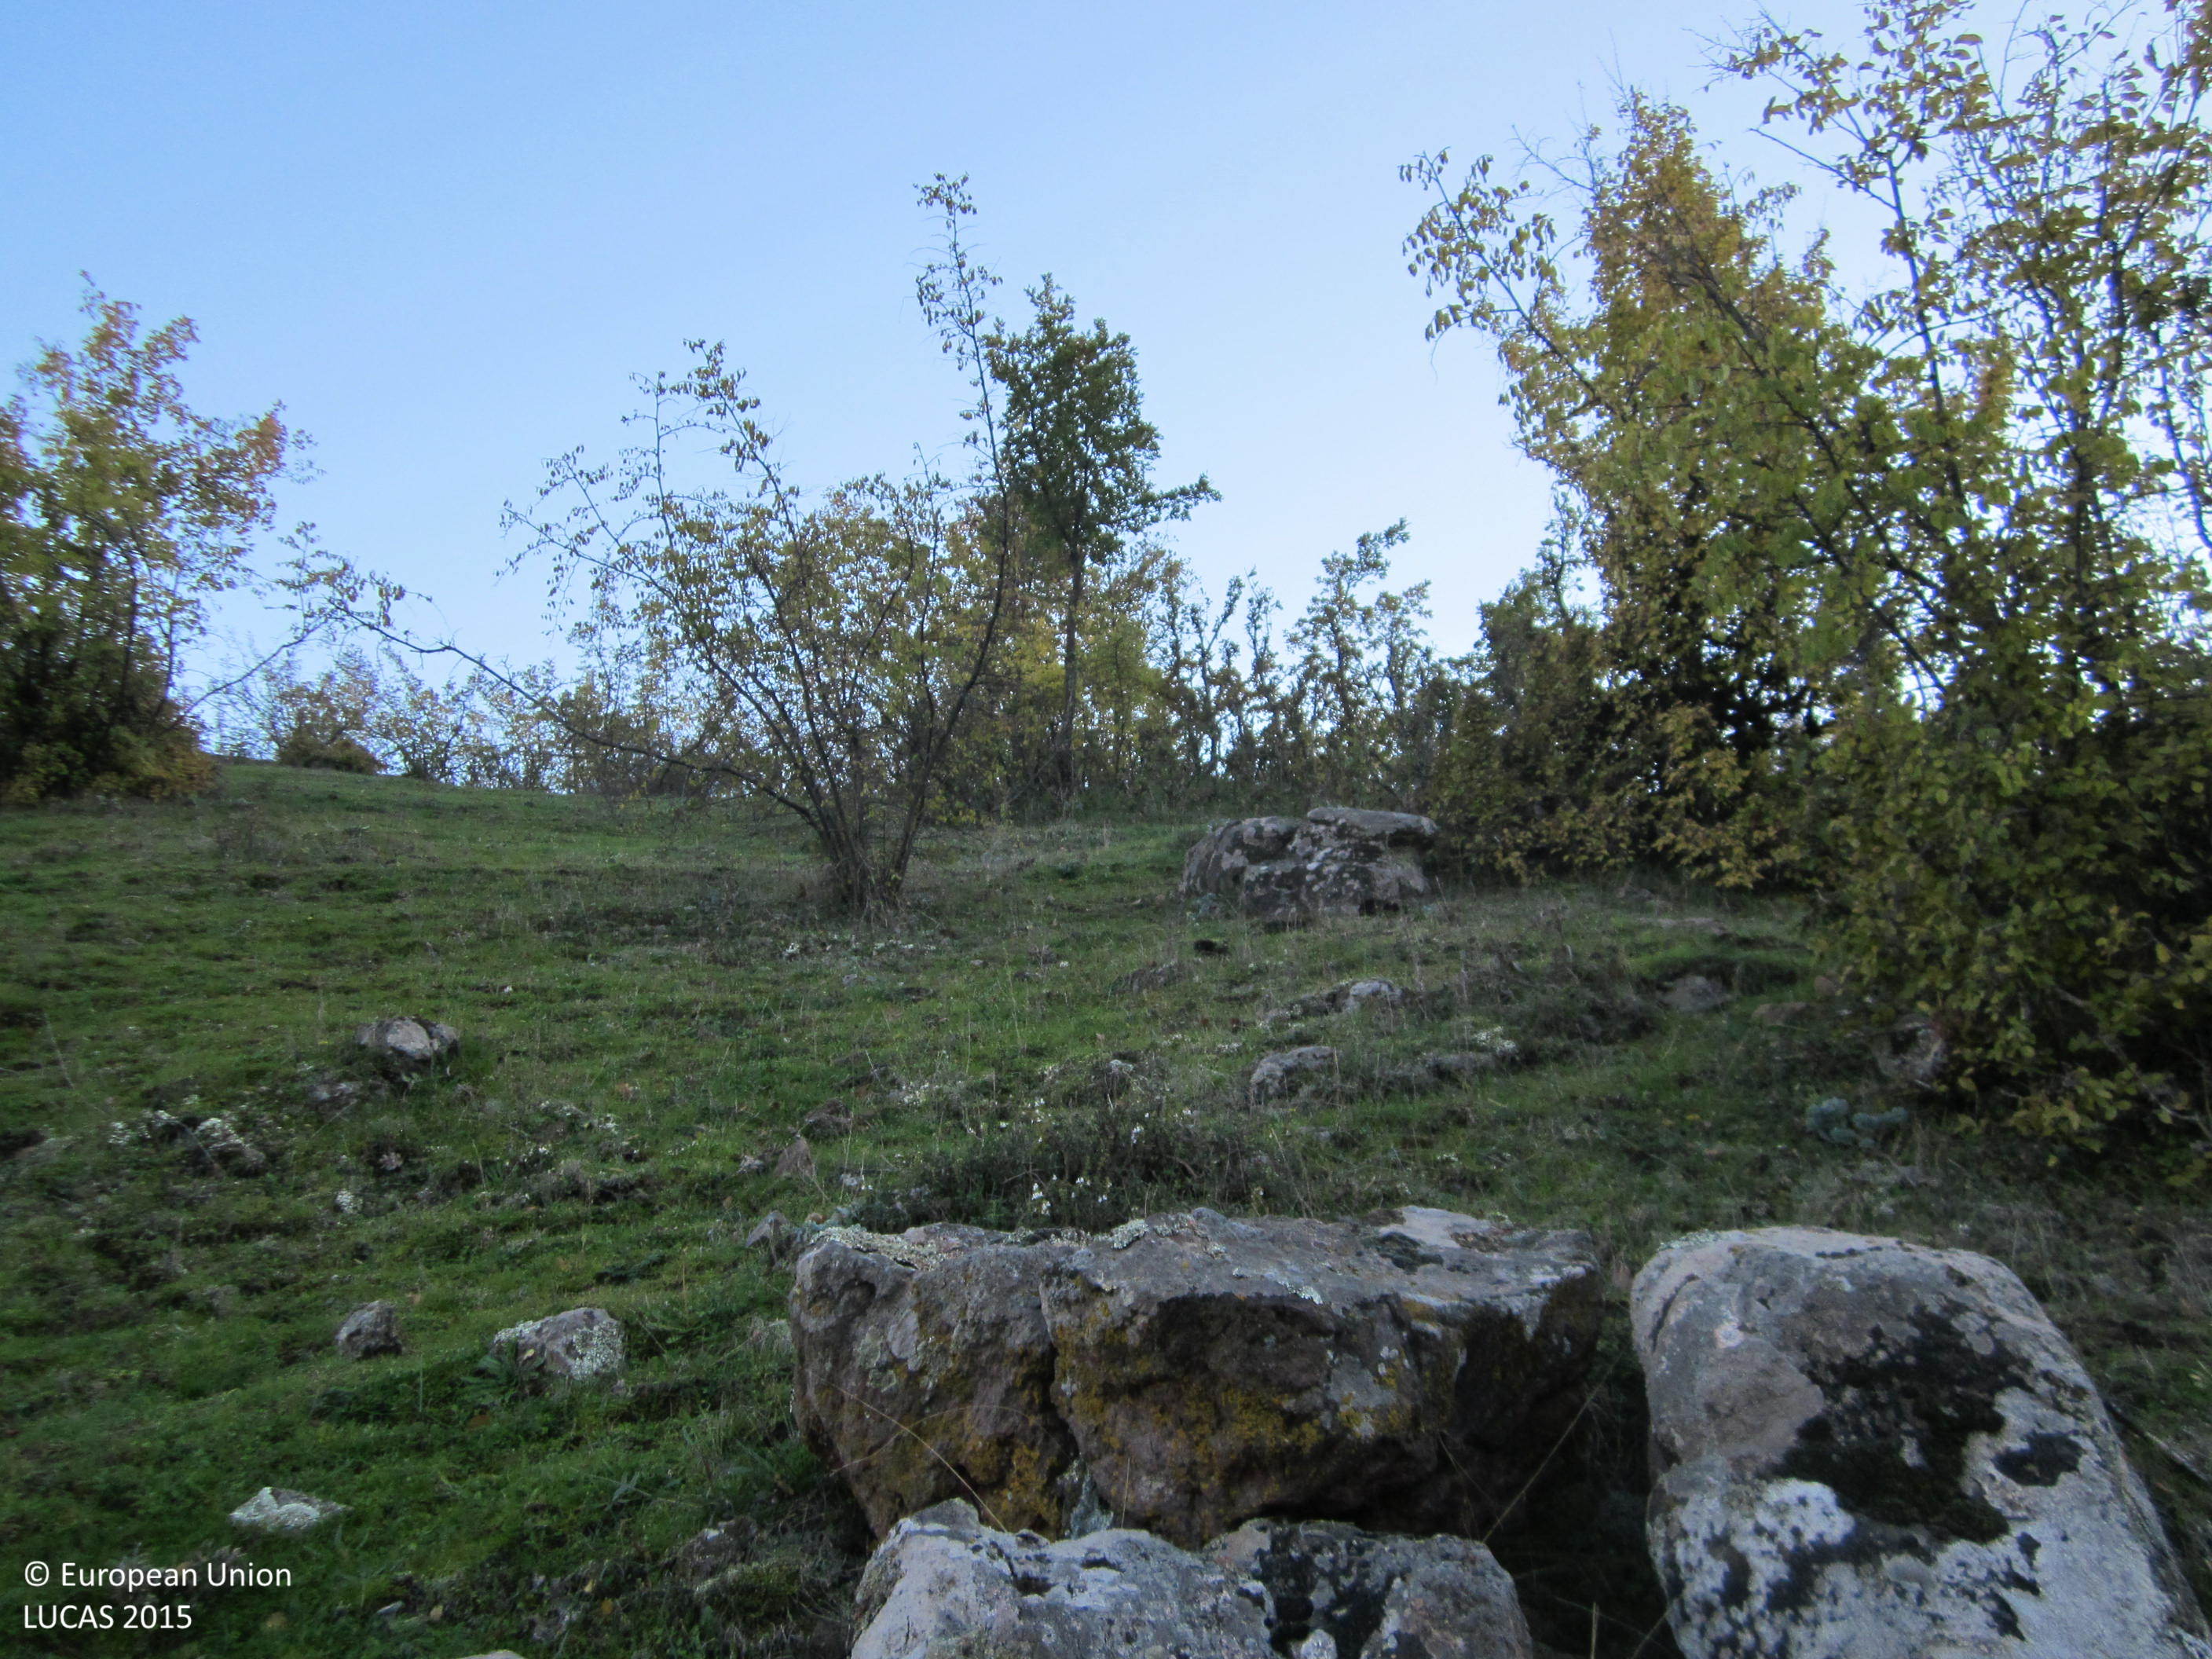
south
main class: Shrubland
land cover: Shrubland with sparse tree cover
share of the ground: 25 - 50 %
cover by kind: herbaceous plants 45 %, shrubs 40 %, unconsolidated bare surface 10 %, broadleaved forest trees 5 %
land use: Agriculture (excluding fallow land and kitchen gardens)
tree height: < 5 m
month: November
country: BG
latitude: 41.5770
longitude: 25.6412
